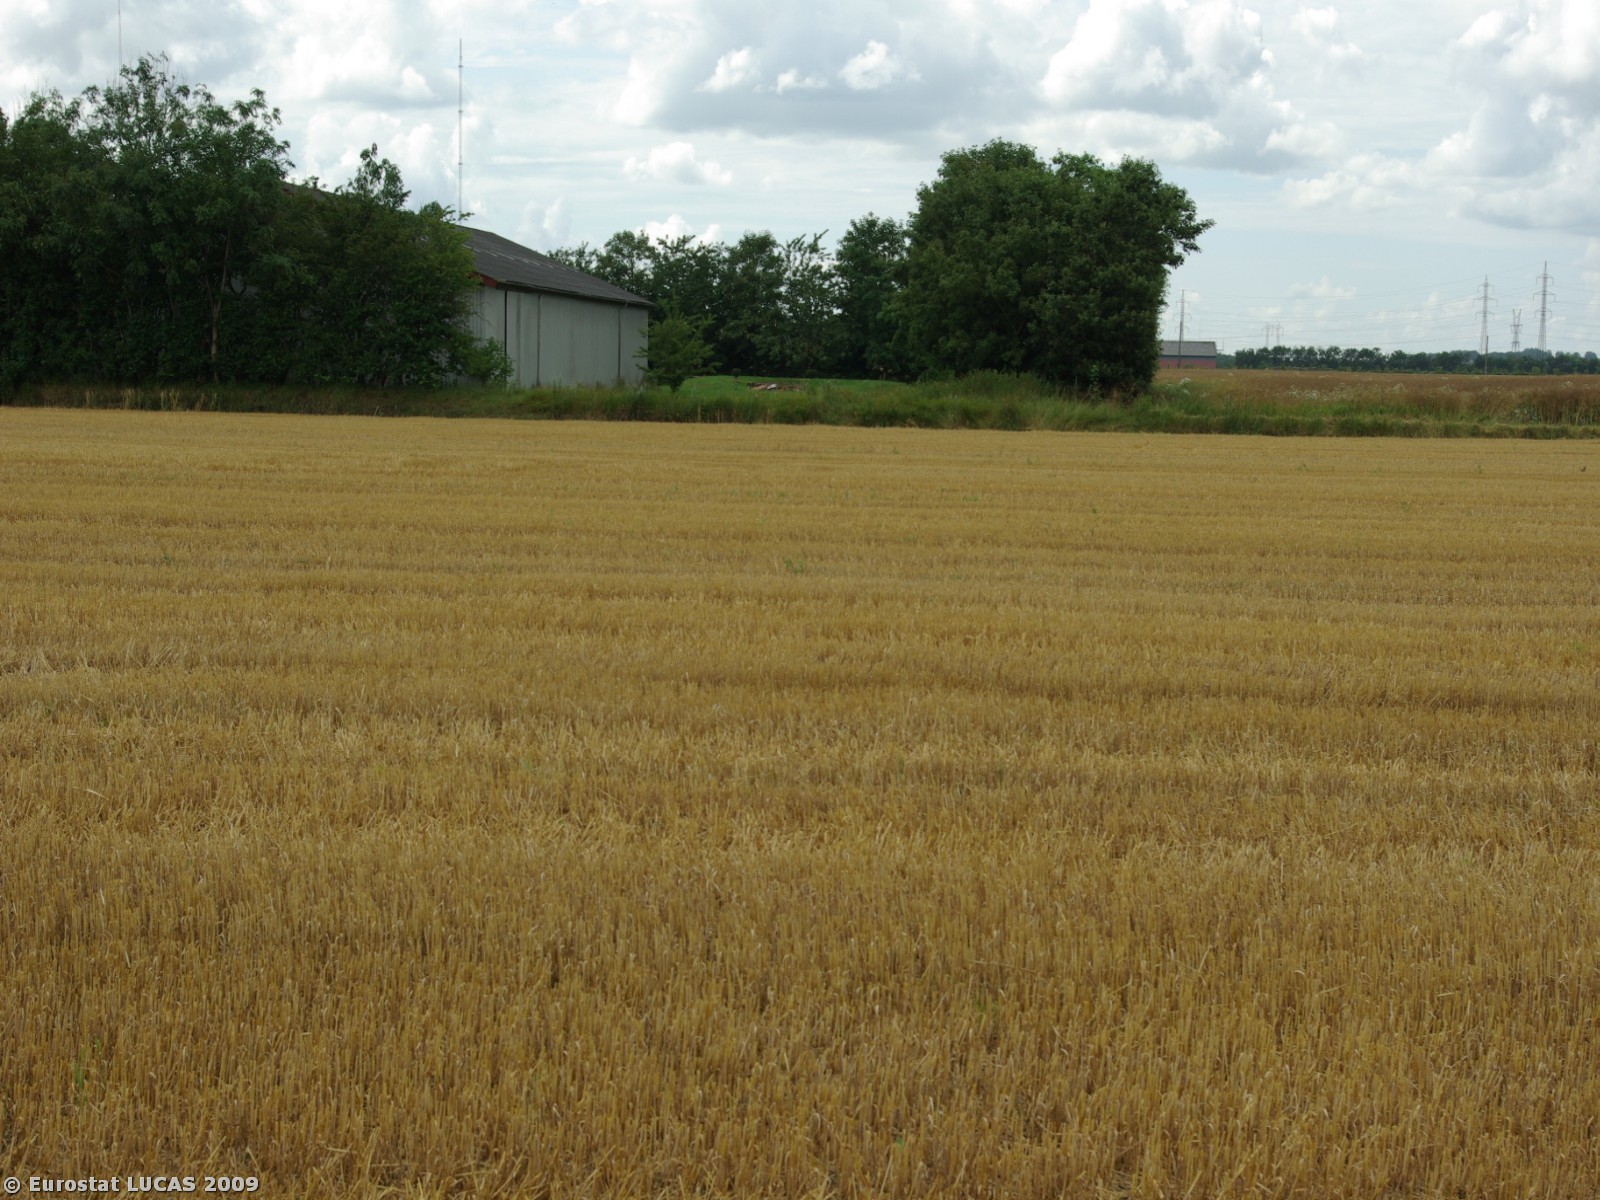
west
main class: Cropland
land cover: Barley
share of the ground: < 10 %
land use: Agriculture (excluding fallow land and kitchen gardens)
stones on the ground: > 50 %
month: July
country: DK
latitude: 55.0354
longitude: 9.2965
